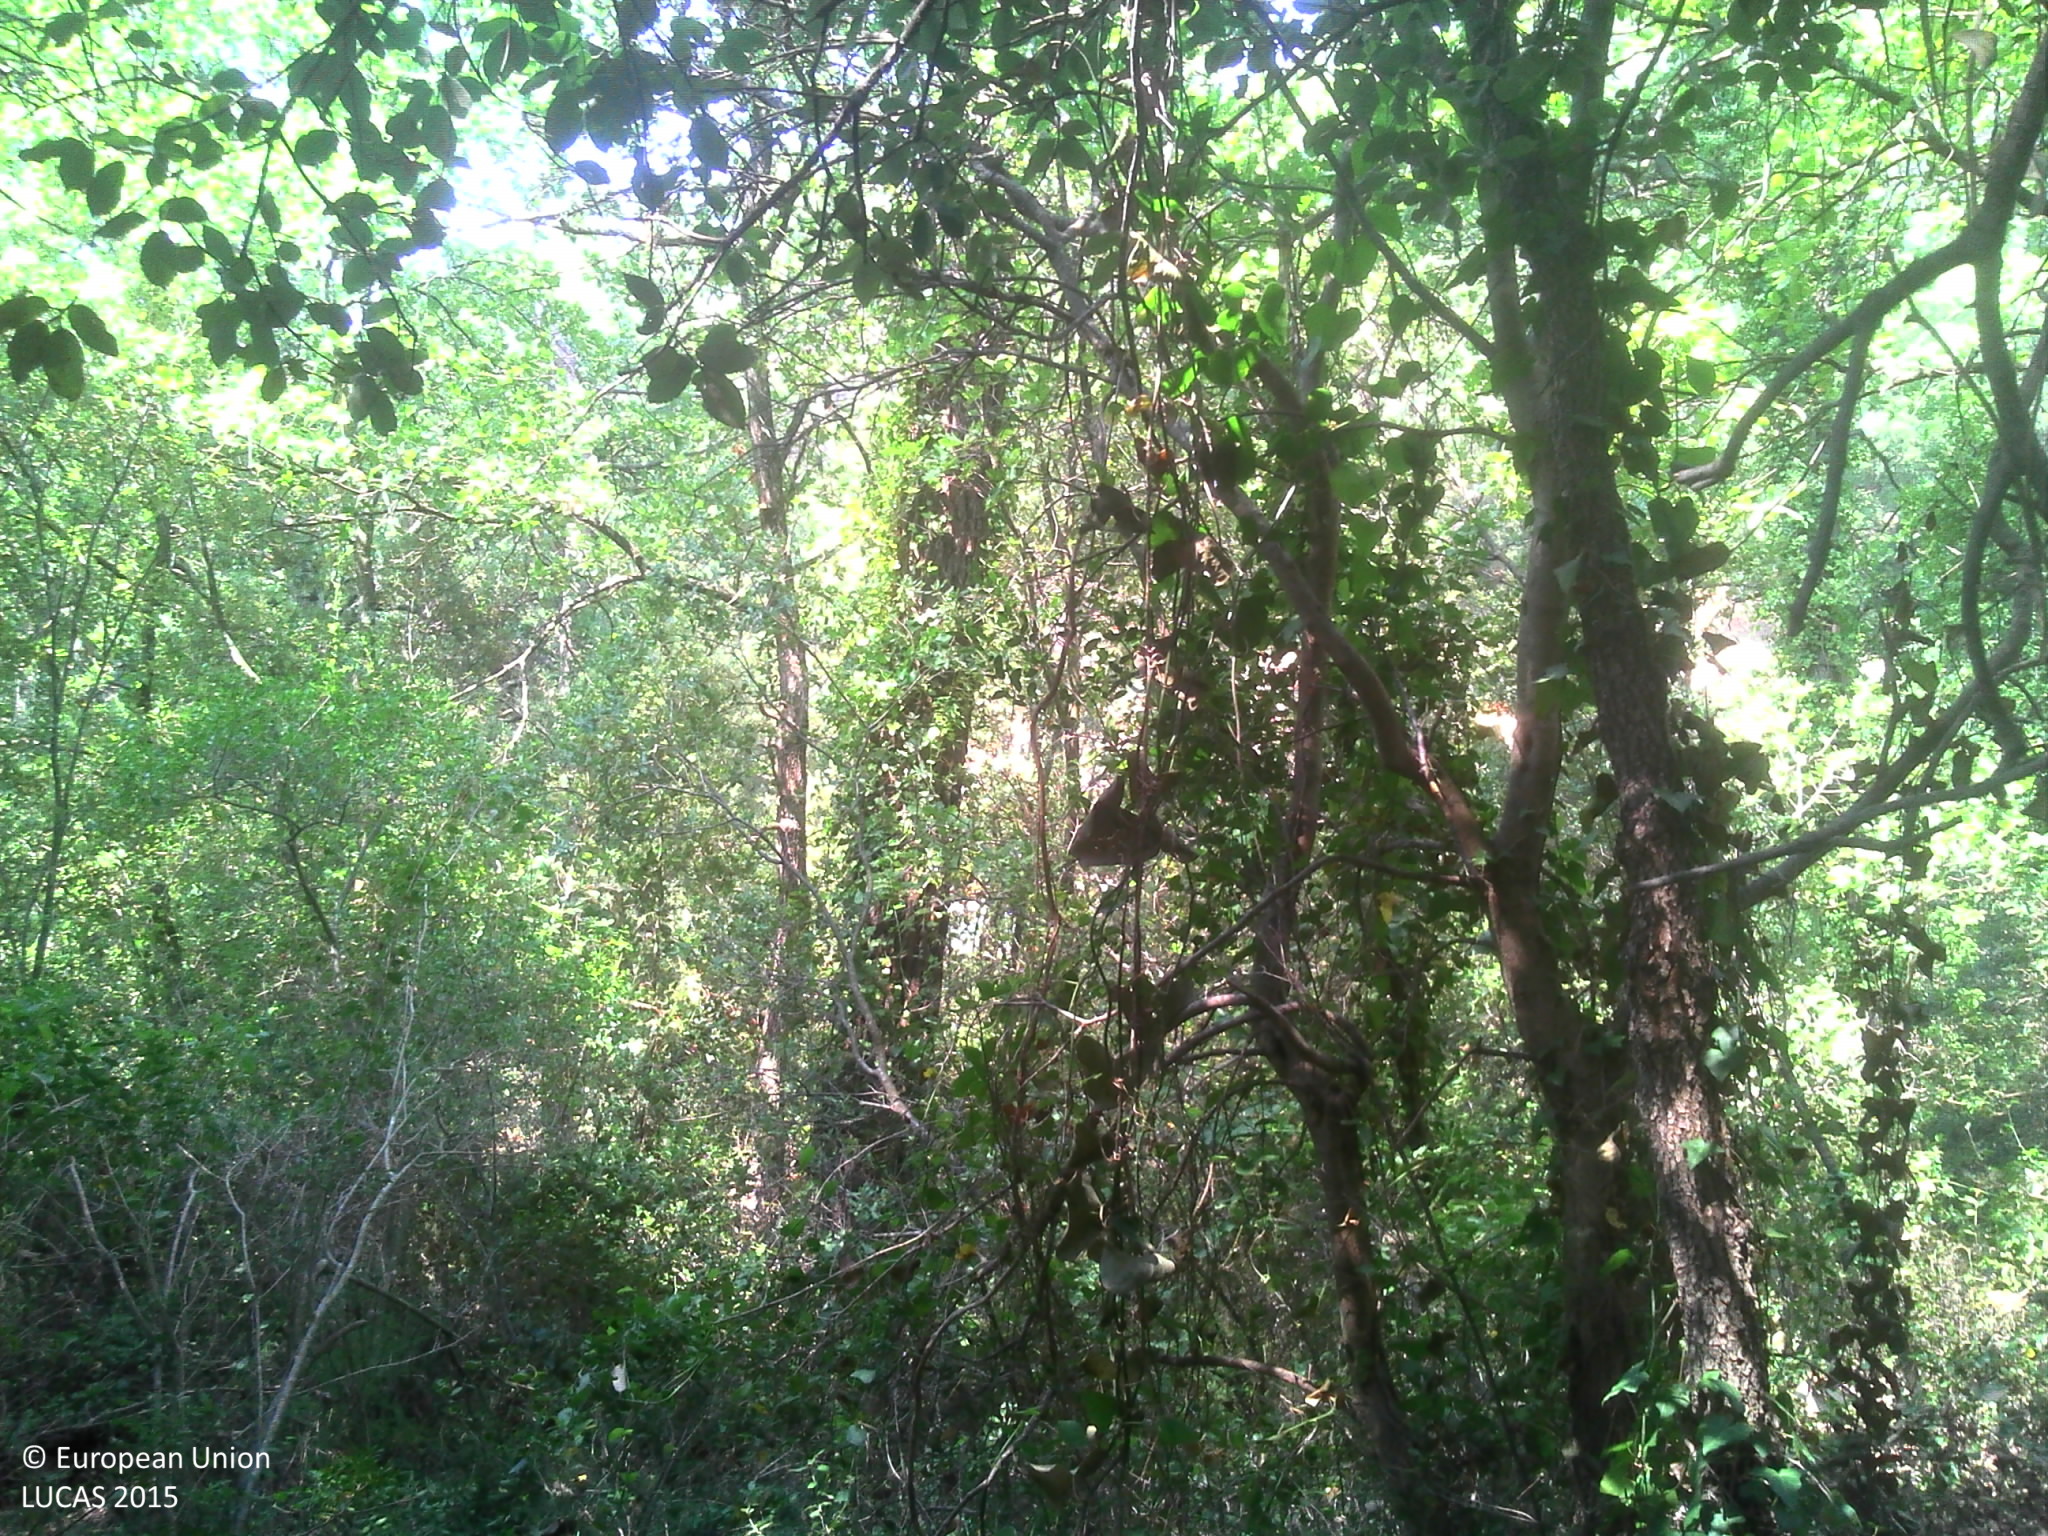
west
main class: Woodland
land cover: Pine dominated mixed woodland
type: broadleaved evergreen forest
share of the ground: > 75 %
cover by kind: coniferous forest trees 50 %, broadleaved forest trees 30 %, unconsolidated bare surface 10 %
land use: Semi-natural and natural areas not in use
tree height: > 5 m
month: July
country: FR
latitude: 43.3994
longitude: 6.2926
